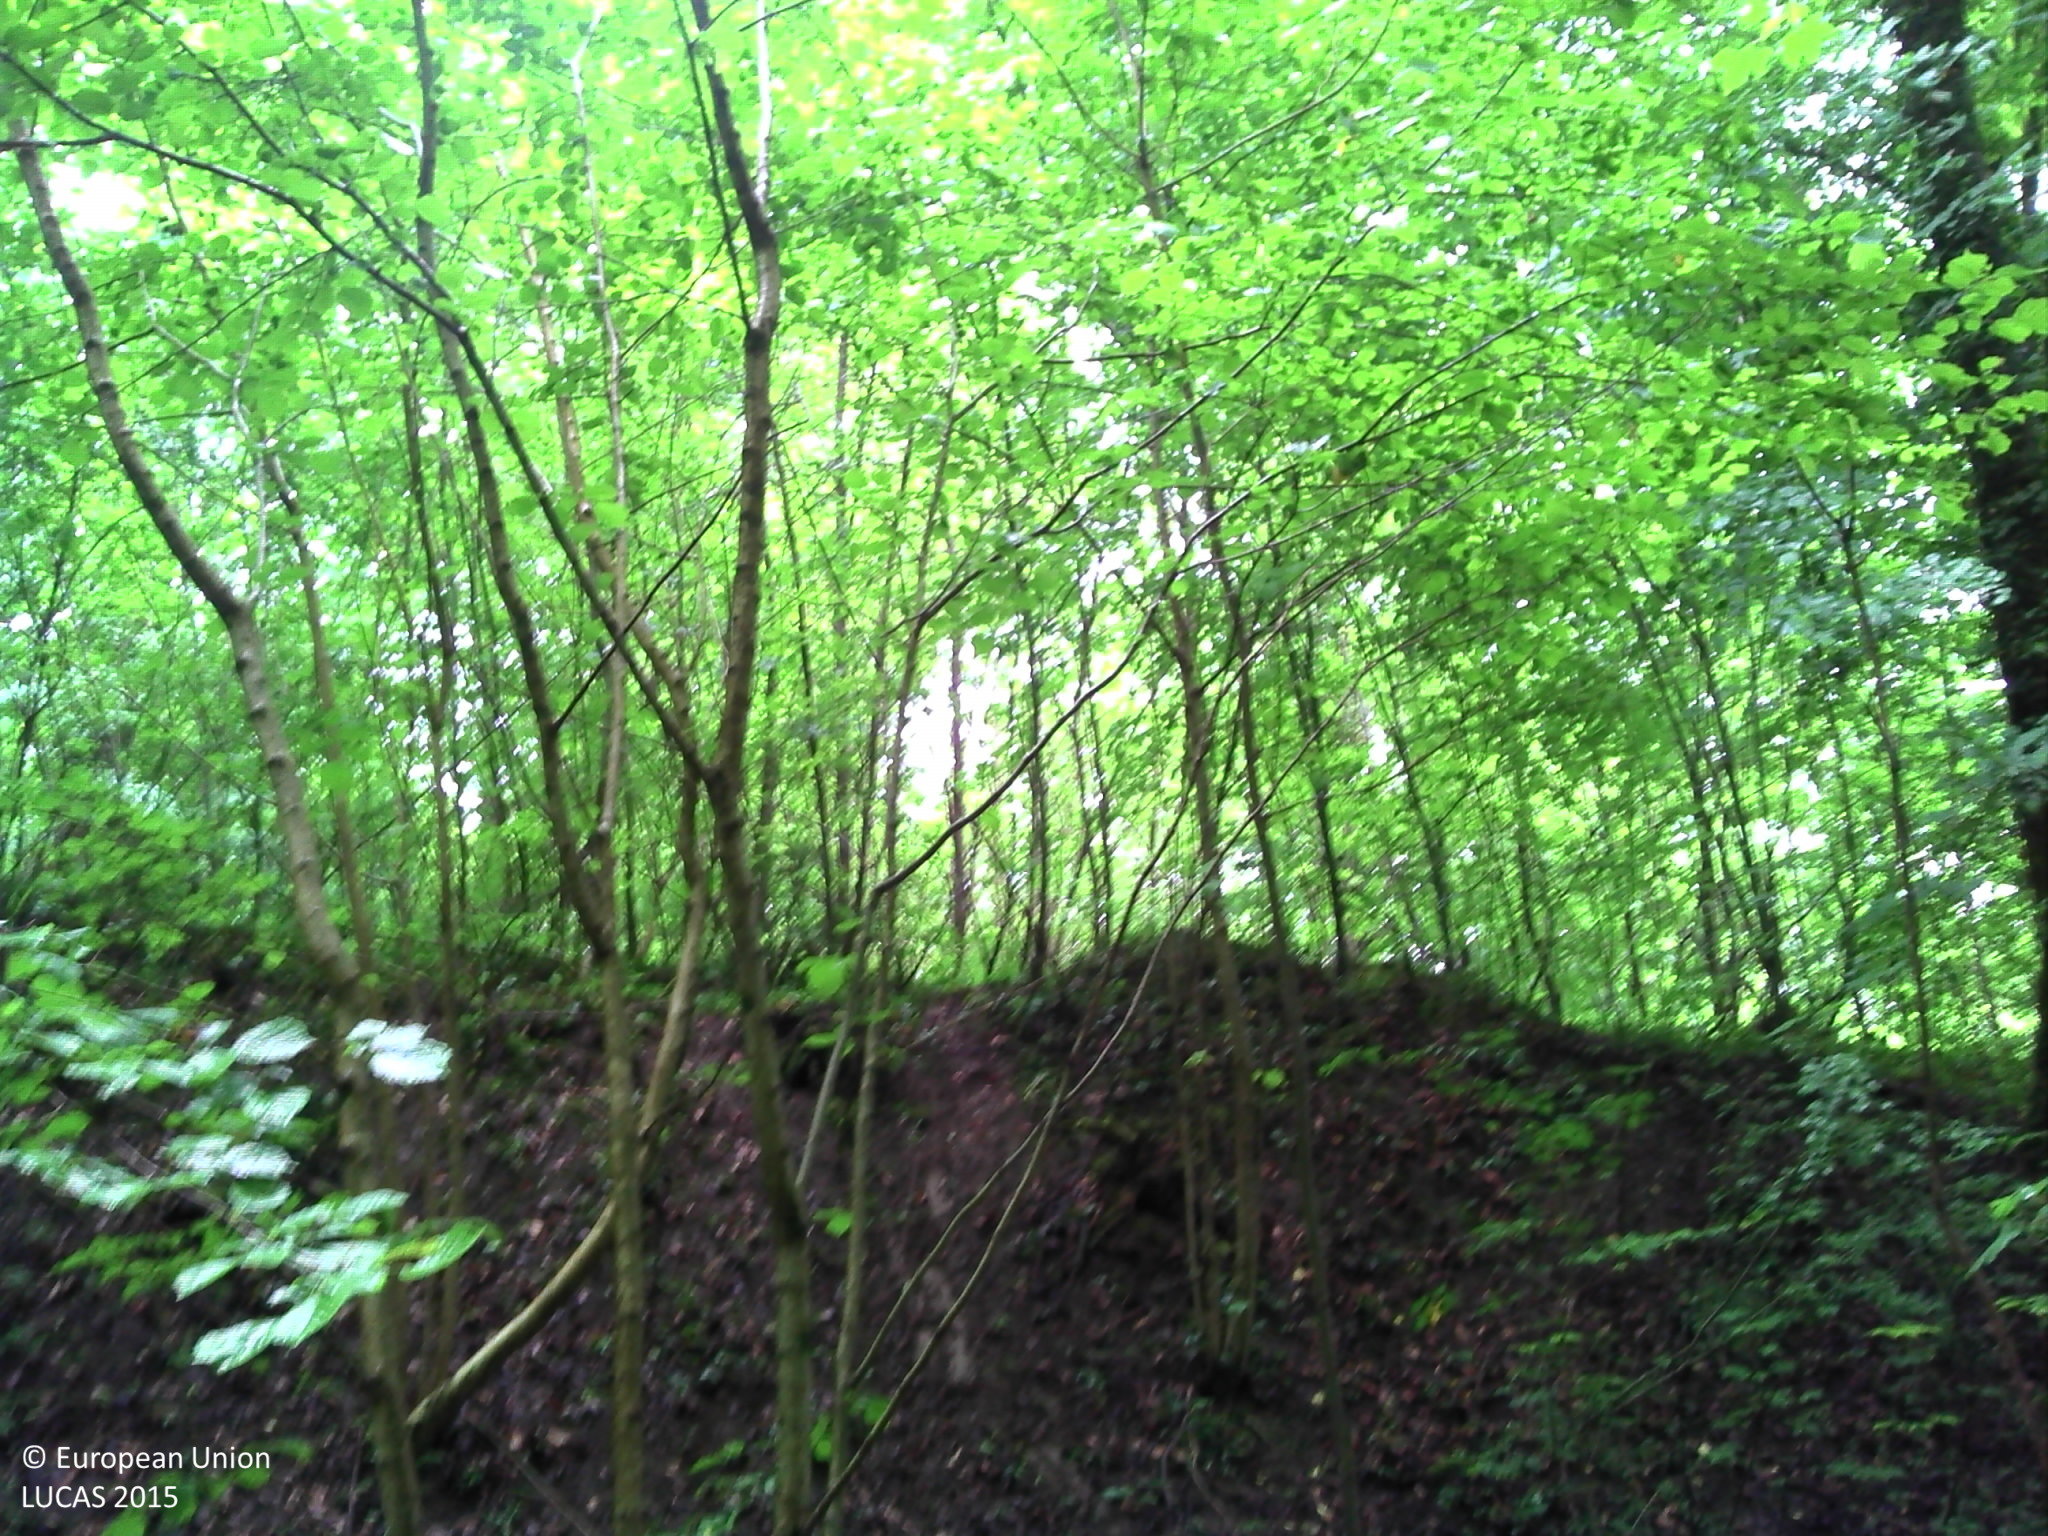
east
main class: Woodland
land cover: Broadleaved woodland
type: mesophytic deciduous forest
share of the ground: > 75 %
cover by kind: broadleaved forest trees 85 %, herbaceous plants 10 %, coniferous forest trees 5 %
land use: Forestry
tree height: > 5 m
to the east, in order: Broadleaved woodland; Grass margins; Tracks; Broadleaved woodland
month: May
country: FR
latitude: 48.6146
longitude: 4.9930
